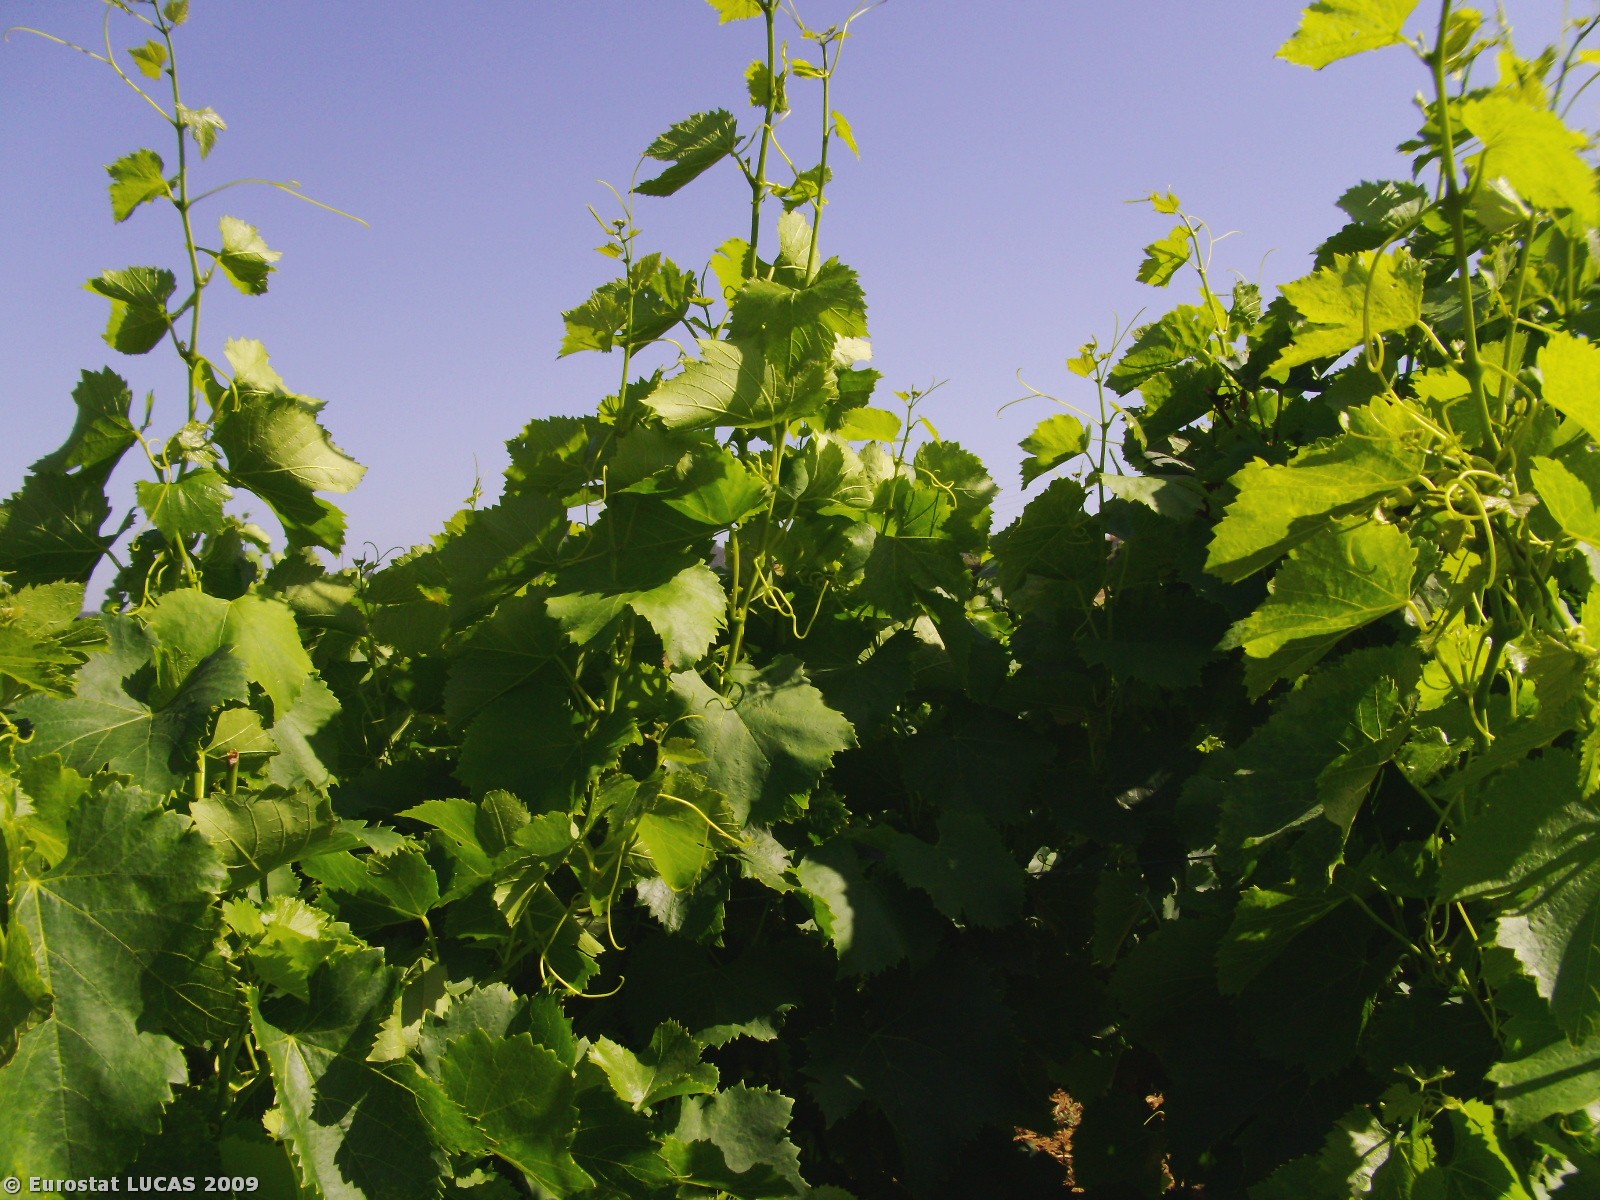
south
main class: Cropland
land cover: Vineyards
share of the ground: 50 - 75 %
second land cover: Bare land
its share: 50 - 75 %
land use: Agriculture (excluding fallow land and kitchen gardens)
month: July
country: PT
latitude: 39.0307
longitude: -9.3204
